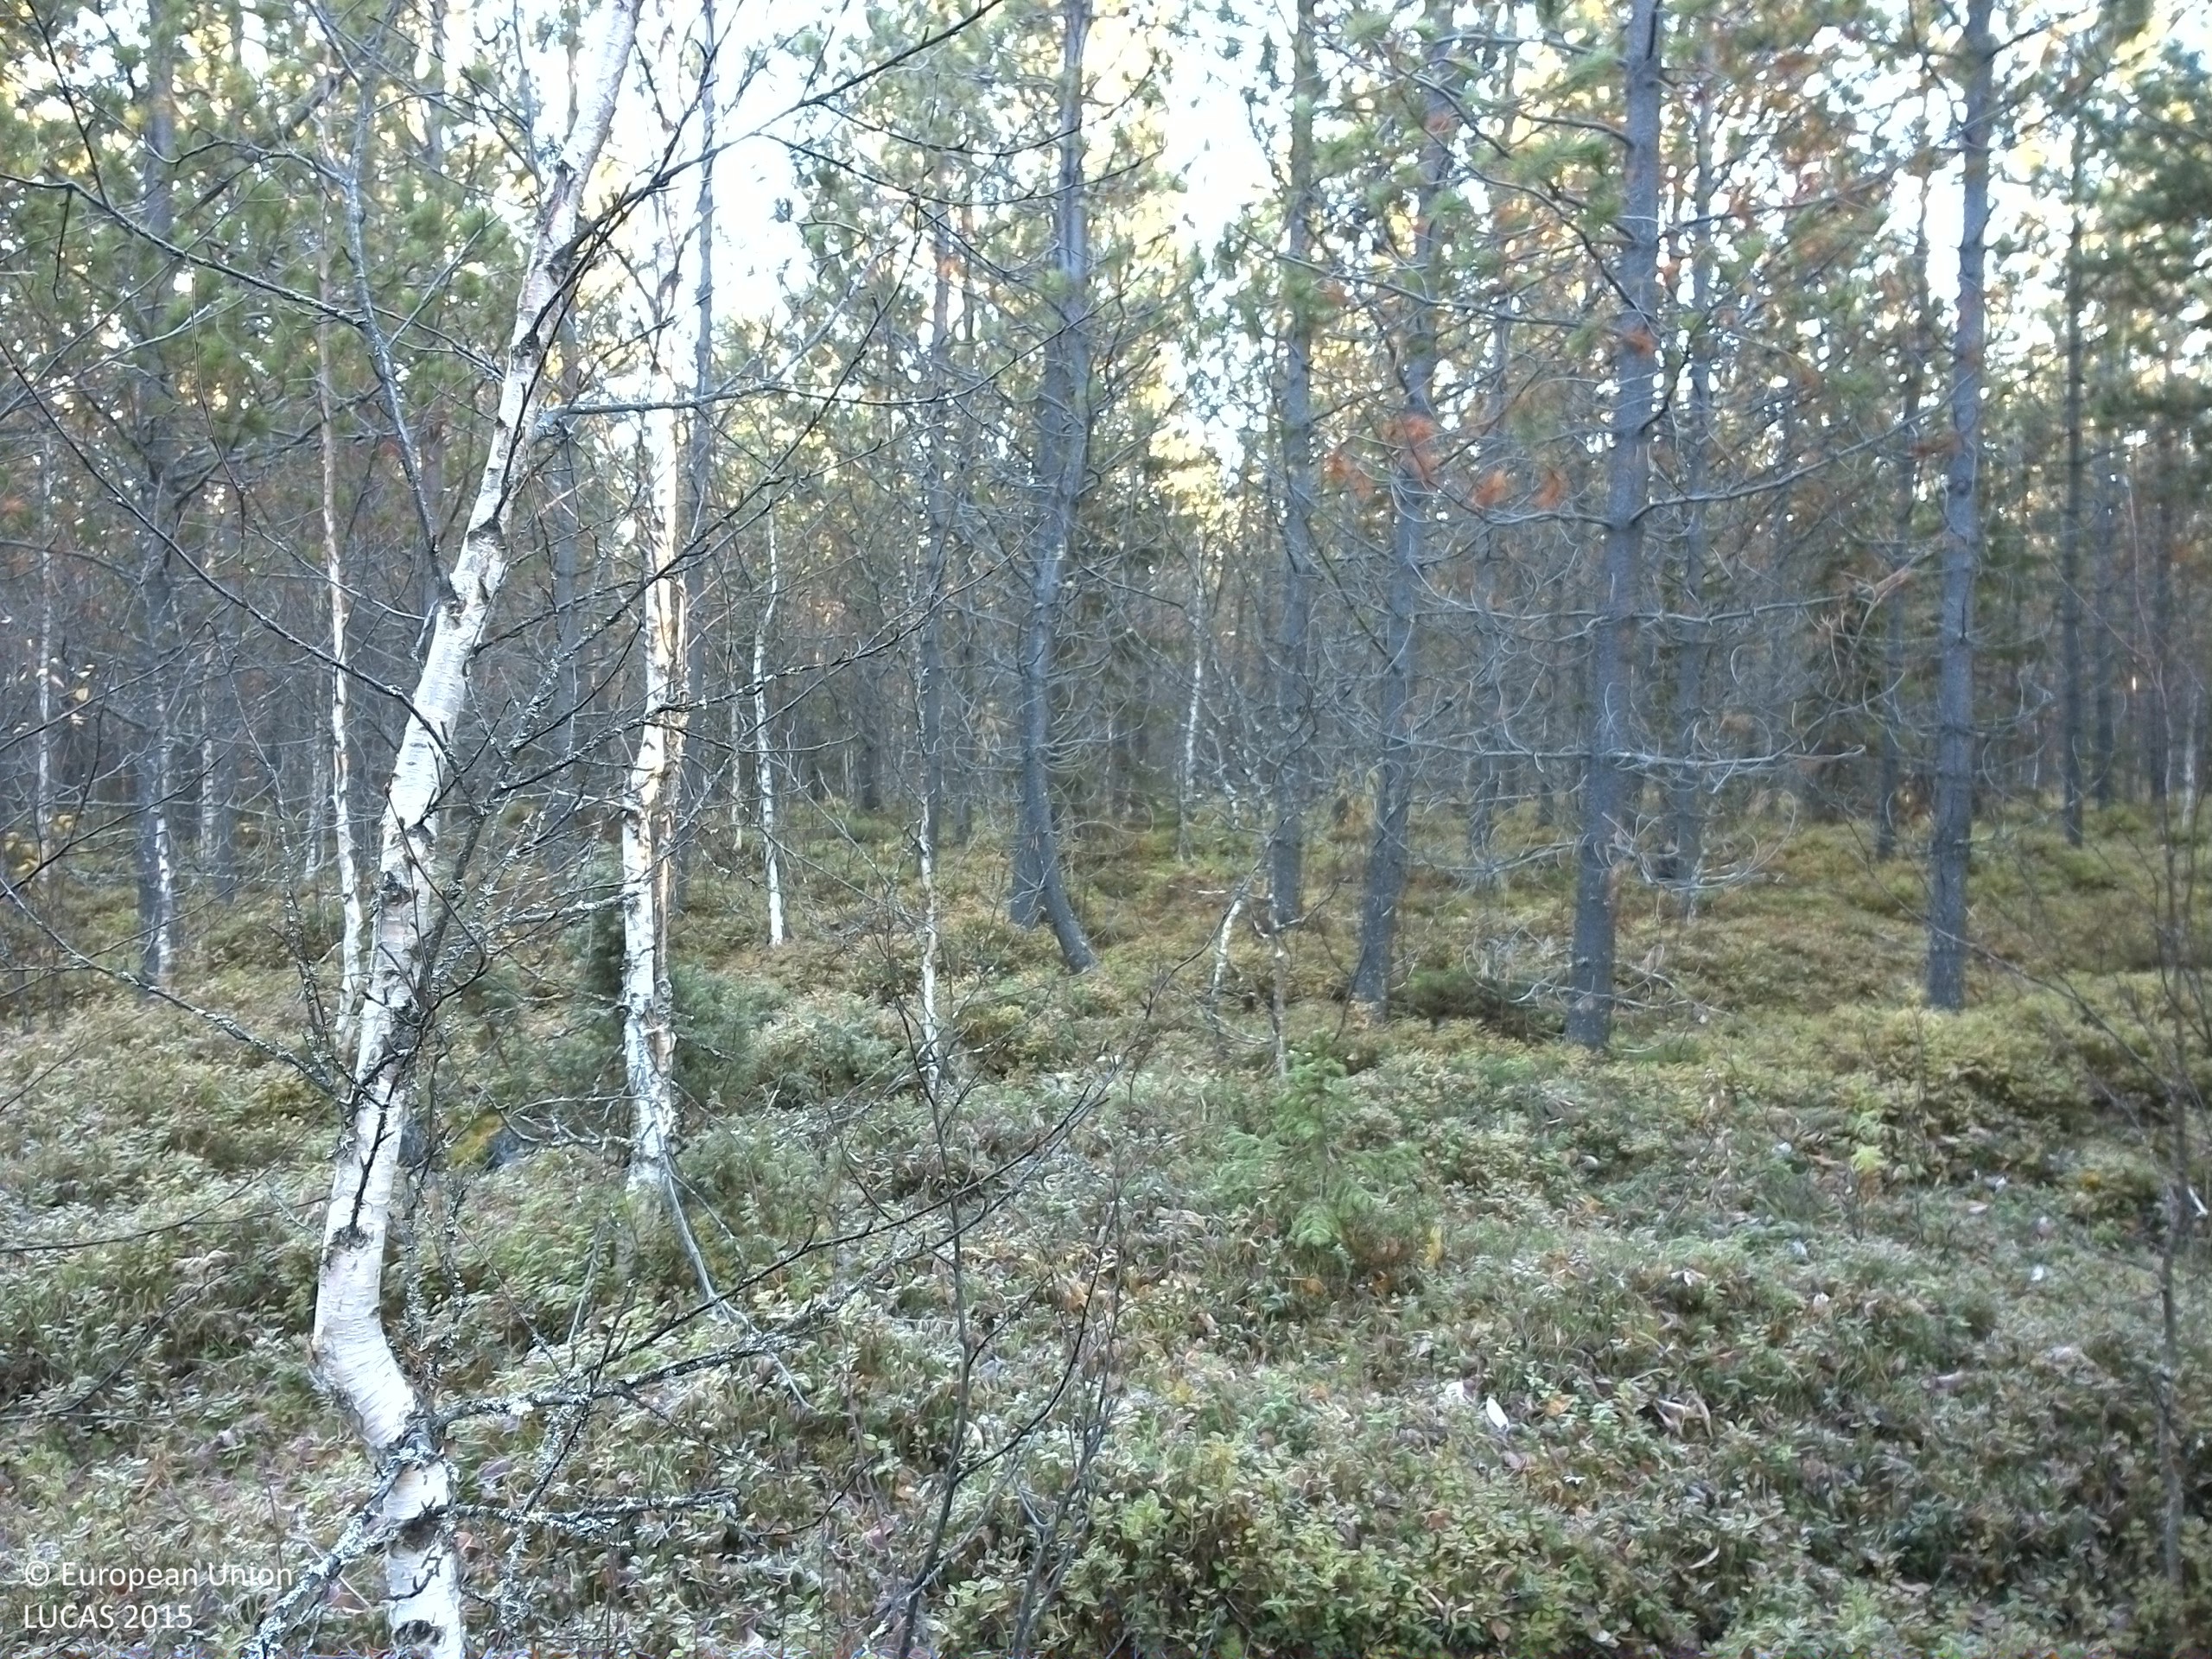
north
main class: Woodland
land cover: Pine dominated mixed woodland
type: exotic forest
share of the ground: 50 - 75 %
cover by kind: coniferous forest trees 40 %, shrubs 35 %, broadleaved forest trees 15 %, lichens and mosses 10 %
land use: Forestry
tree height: > 5 m
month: October
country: SE
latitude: 64.5549
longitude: 15.5394
